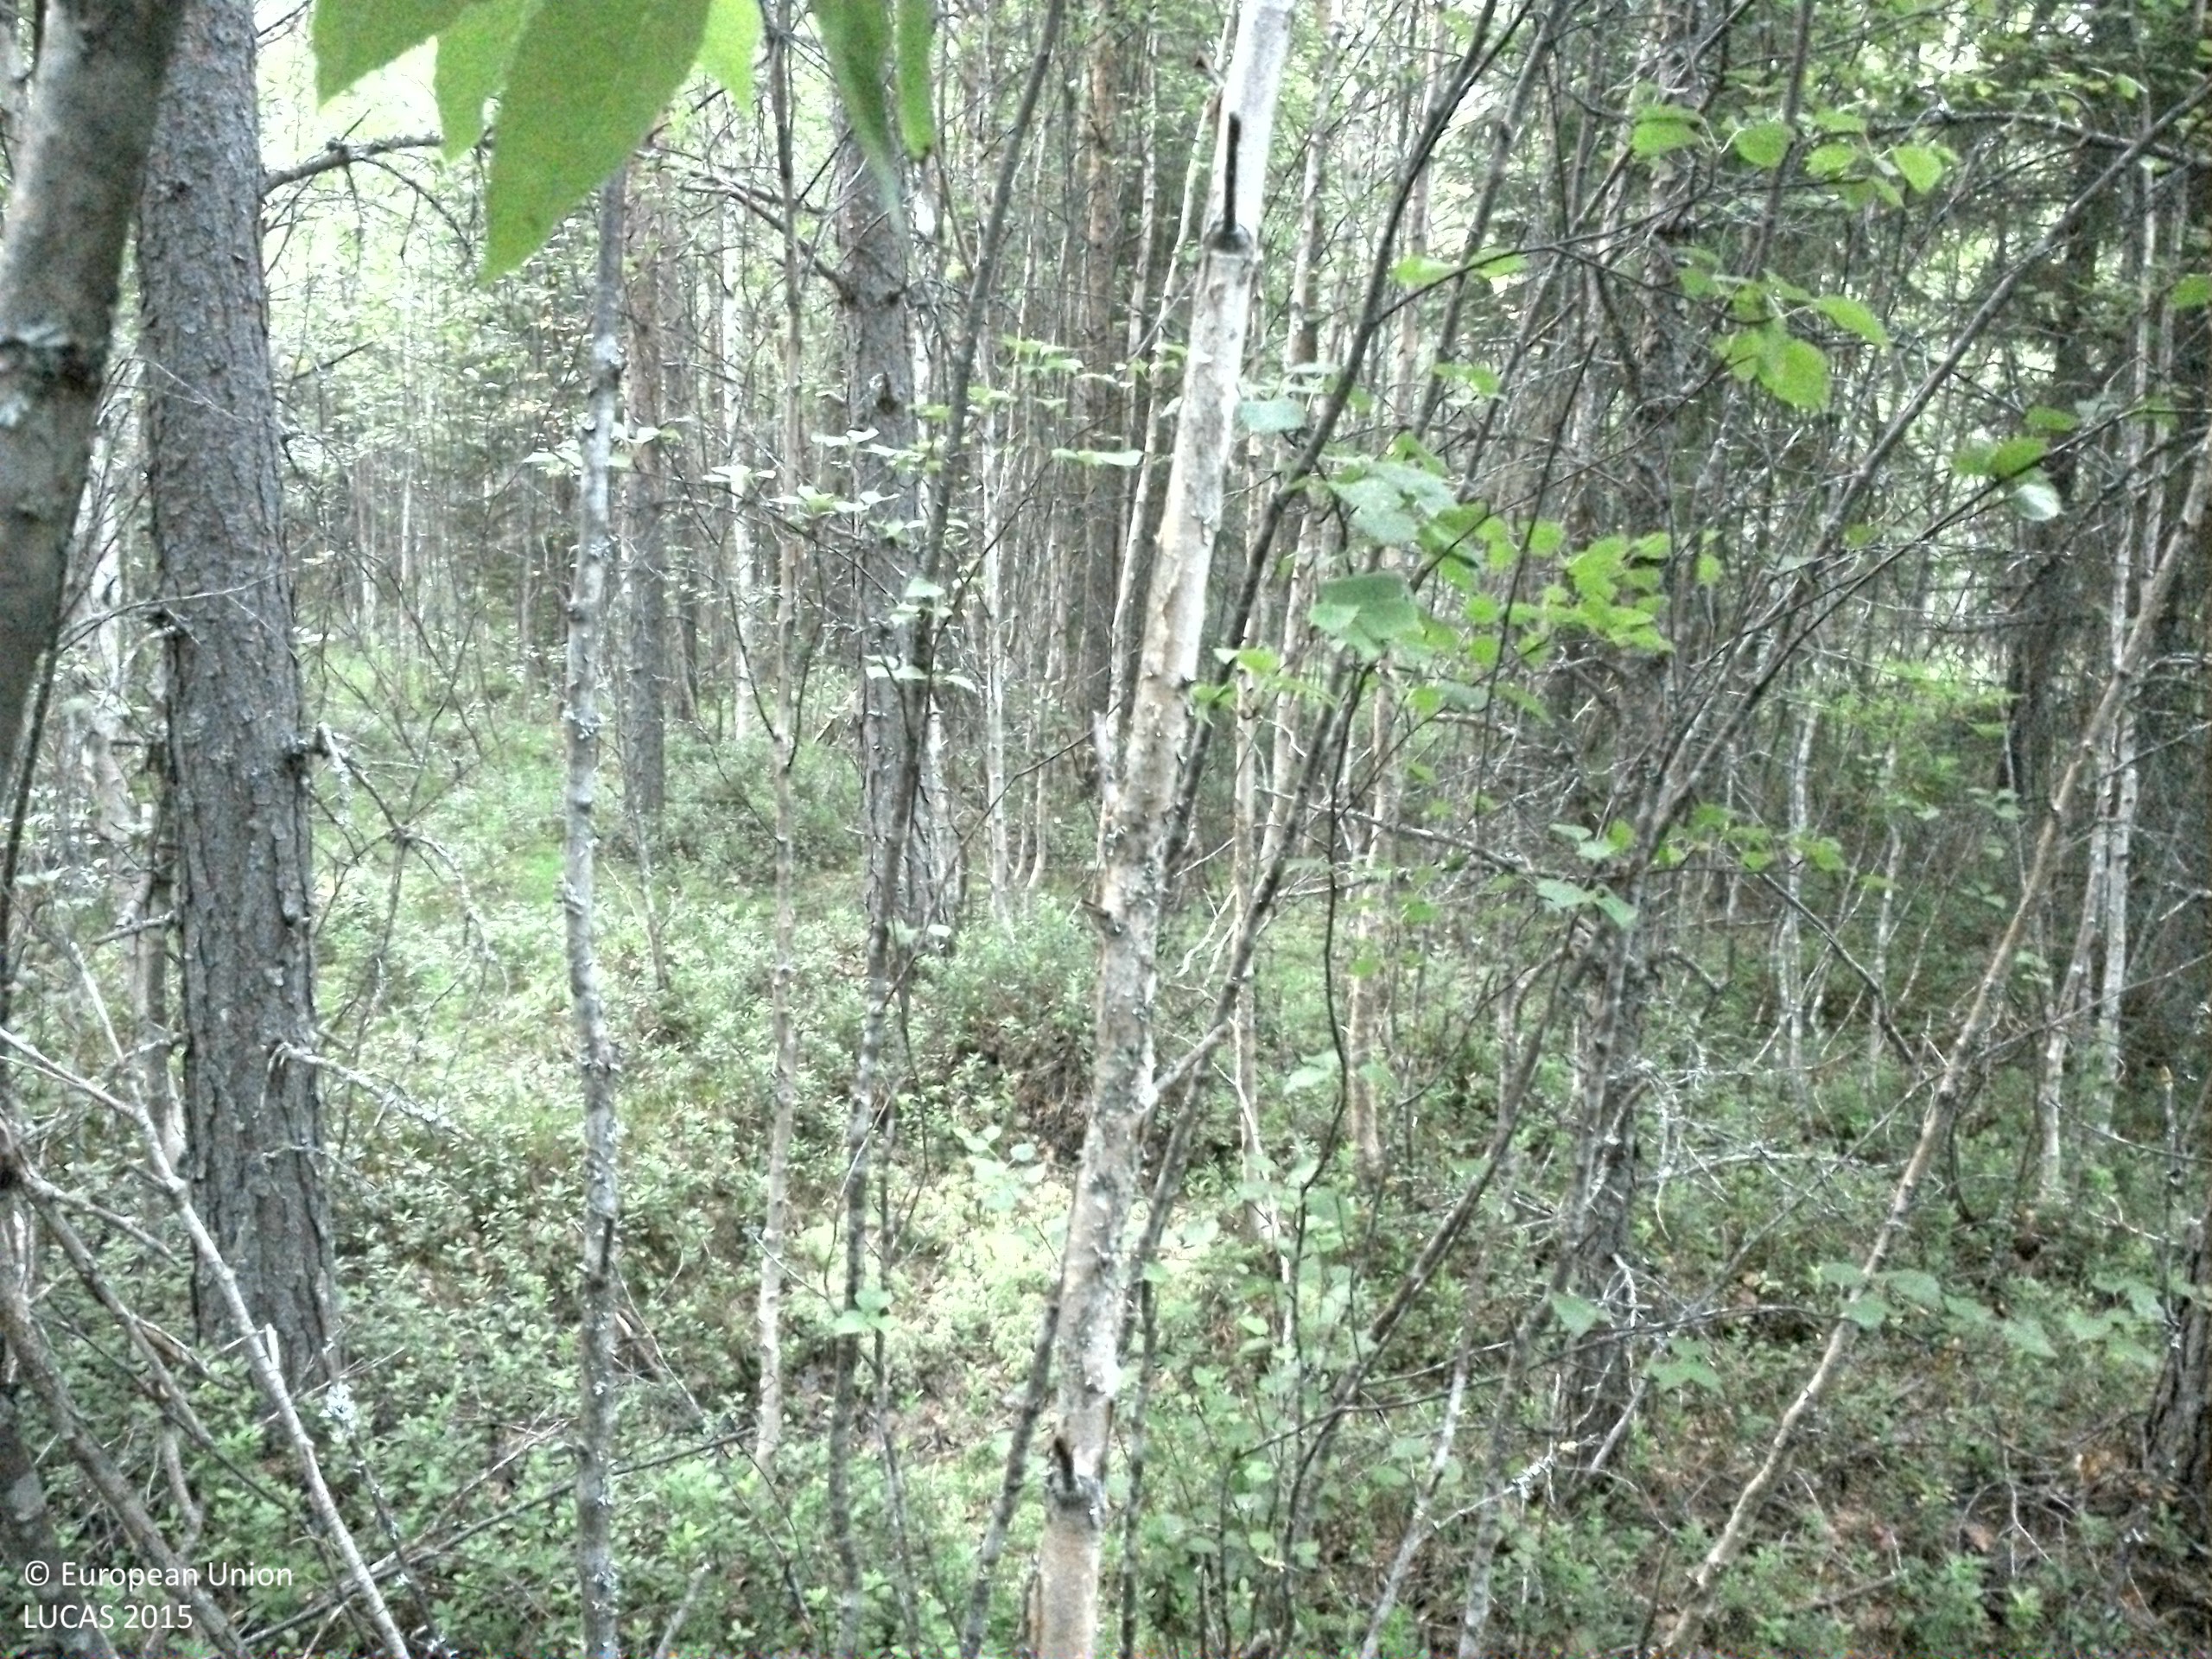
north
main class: Woodland
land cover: Other mixed woodland
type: boreal forest
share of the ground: > 75 %
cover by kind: broadleaved forest trees 50 %, coniferous forest trees 30 %, shrubs 10 %, lichens and mosses 10 %
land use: Forestry
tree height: > 5 m
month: August
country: SE
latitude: 63.6328
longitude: 16.4513
